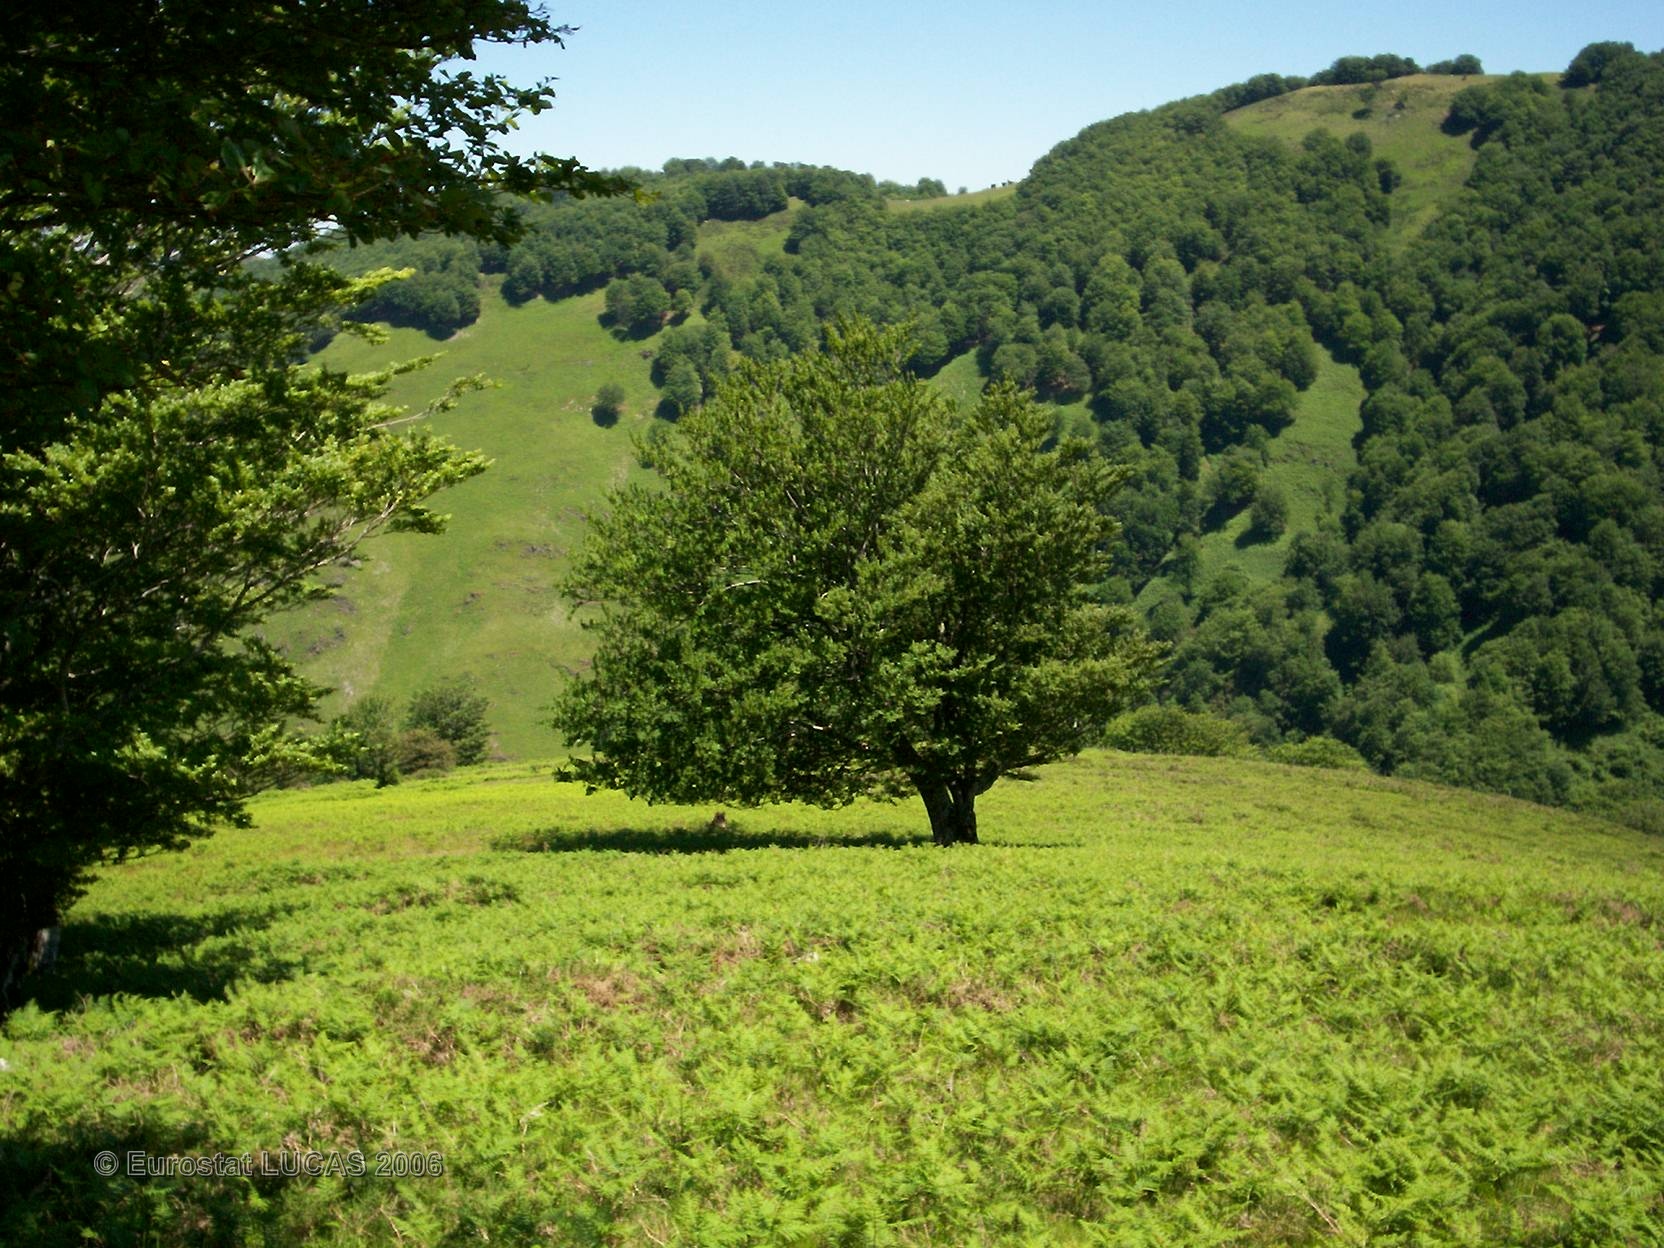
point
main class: Grassland
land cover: Grassland without tree/shrub cover
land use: Fallow land
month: June
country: FR
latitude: 43.0991
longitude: -1.2552
